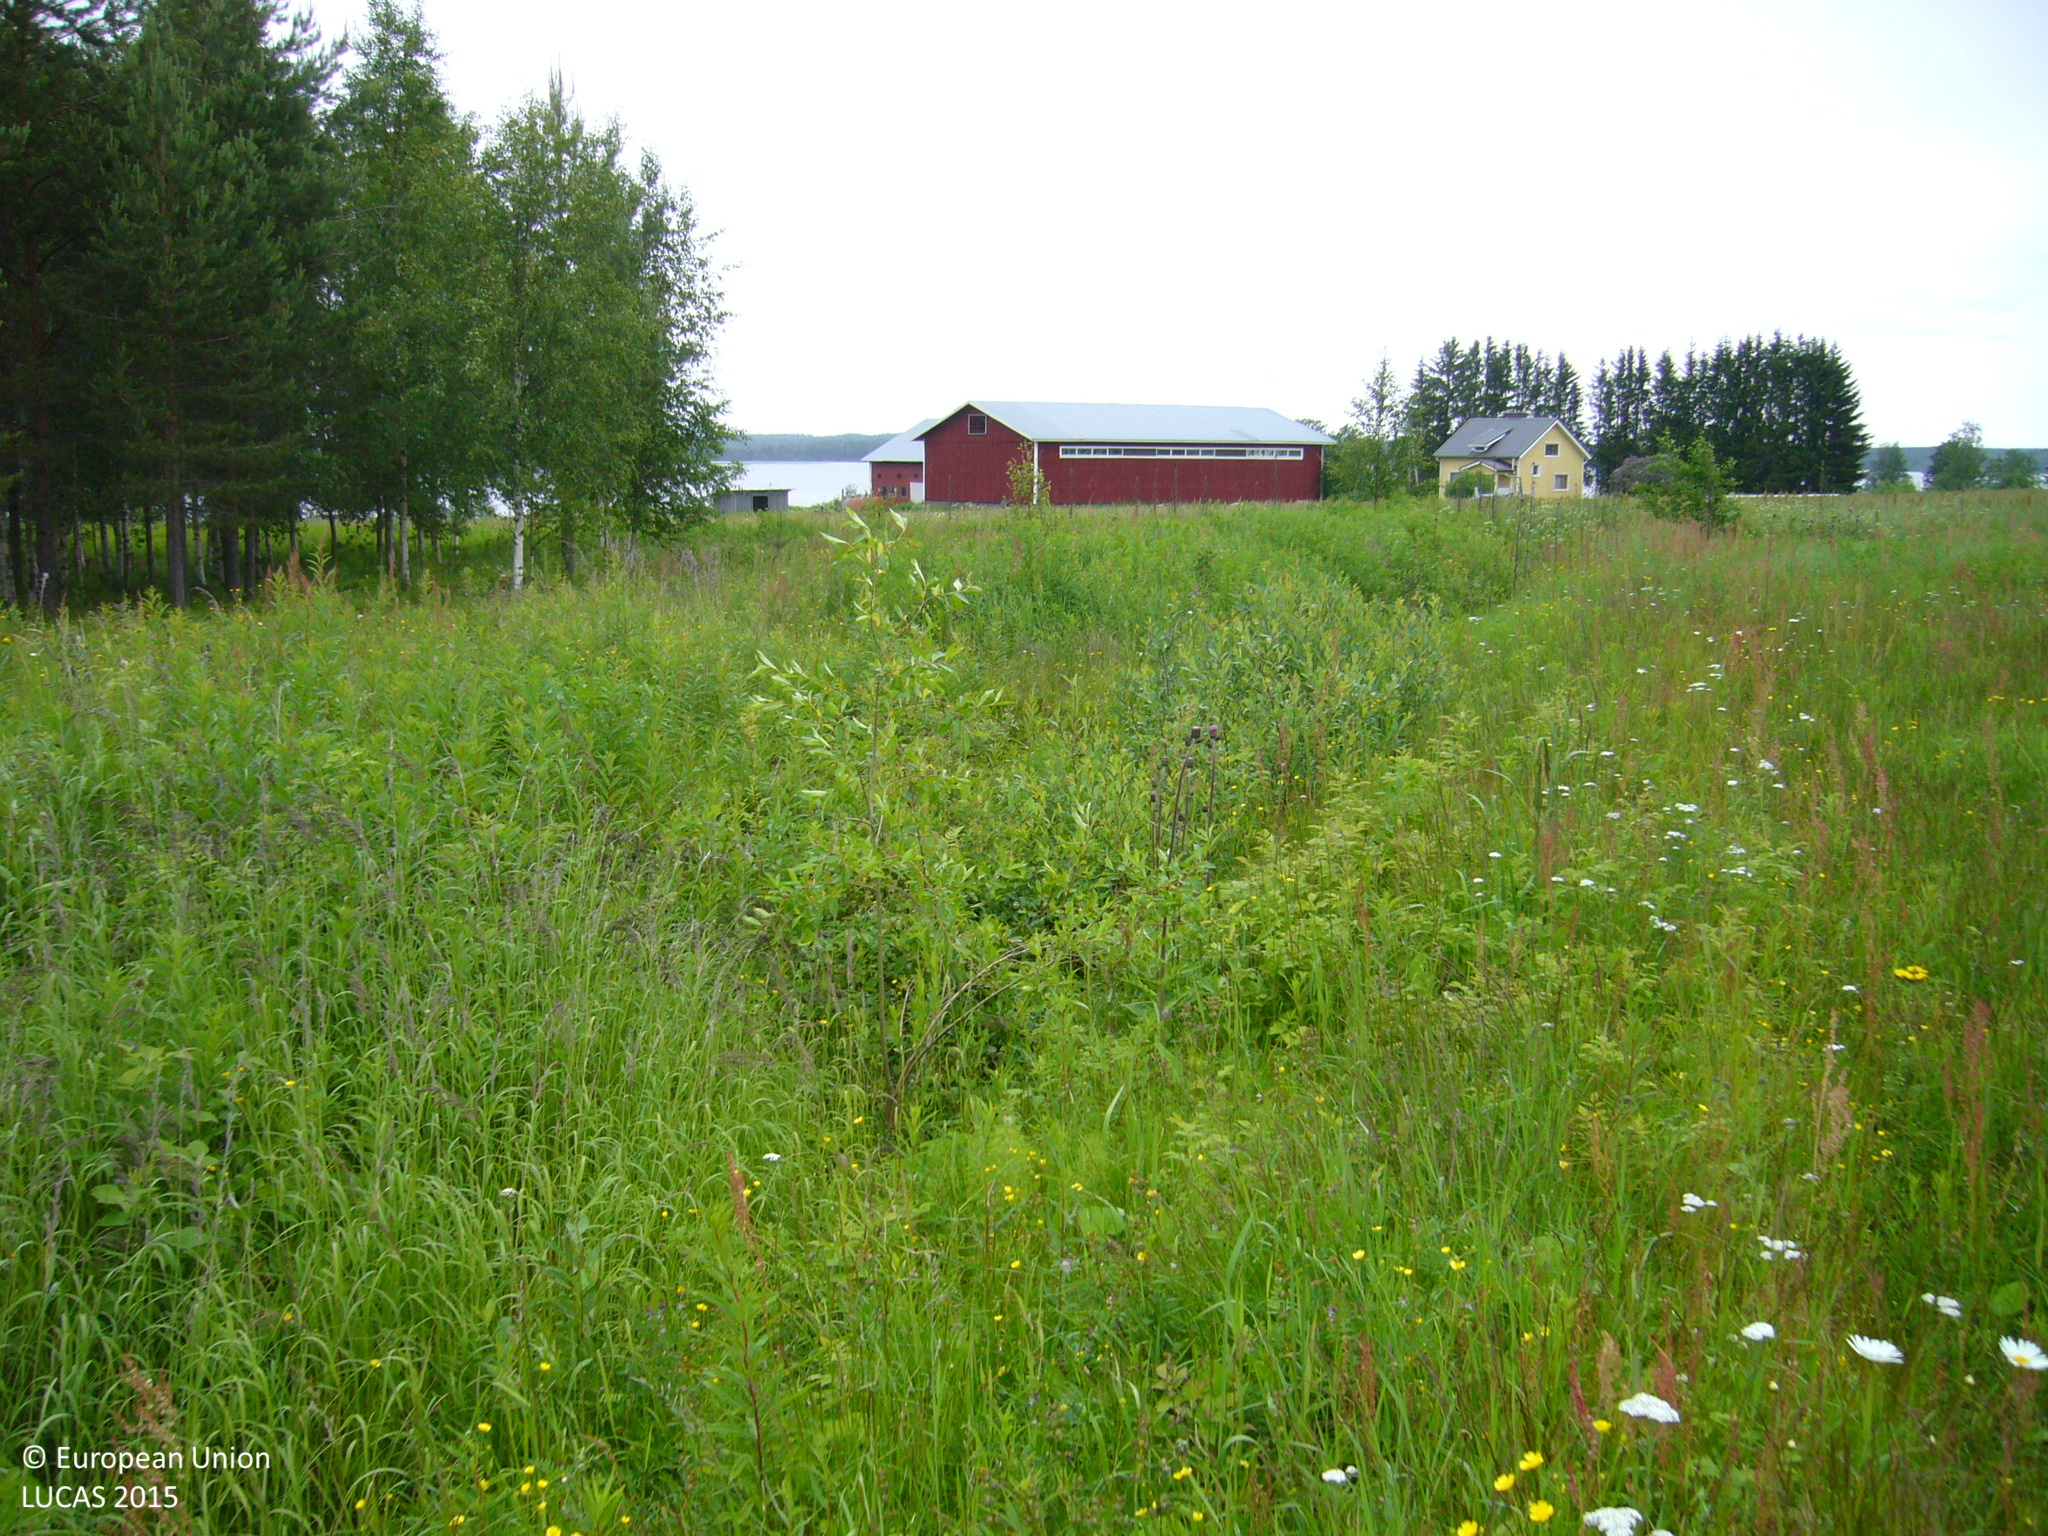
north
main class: Grassland
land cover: Grassland without tree/shrub cover
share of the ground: > 75 %
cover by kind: herbaceous plants 100 %
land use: Agriculture (excluding fallow land and kitchen gardens)
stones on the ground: < 10 %
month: July
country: FI
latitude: 63.4581
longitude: 25.7329
